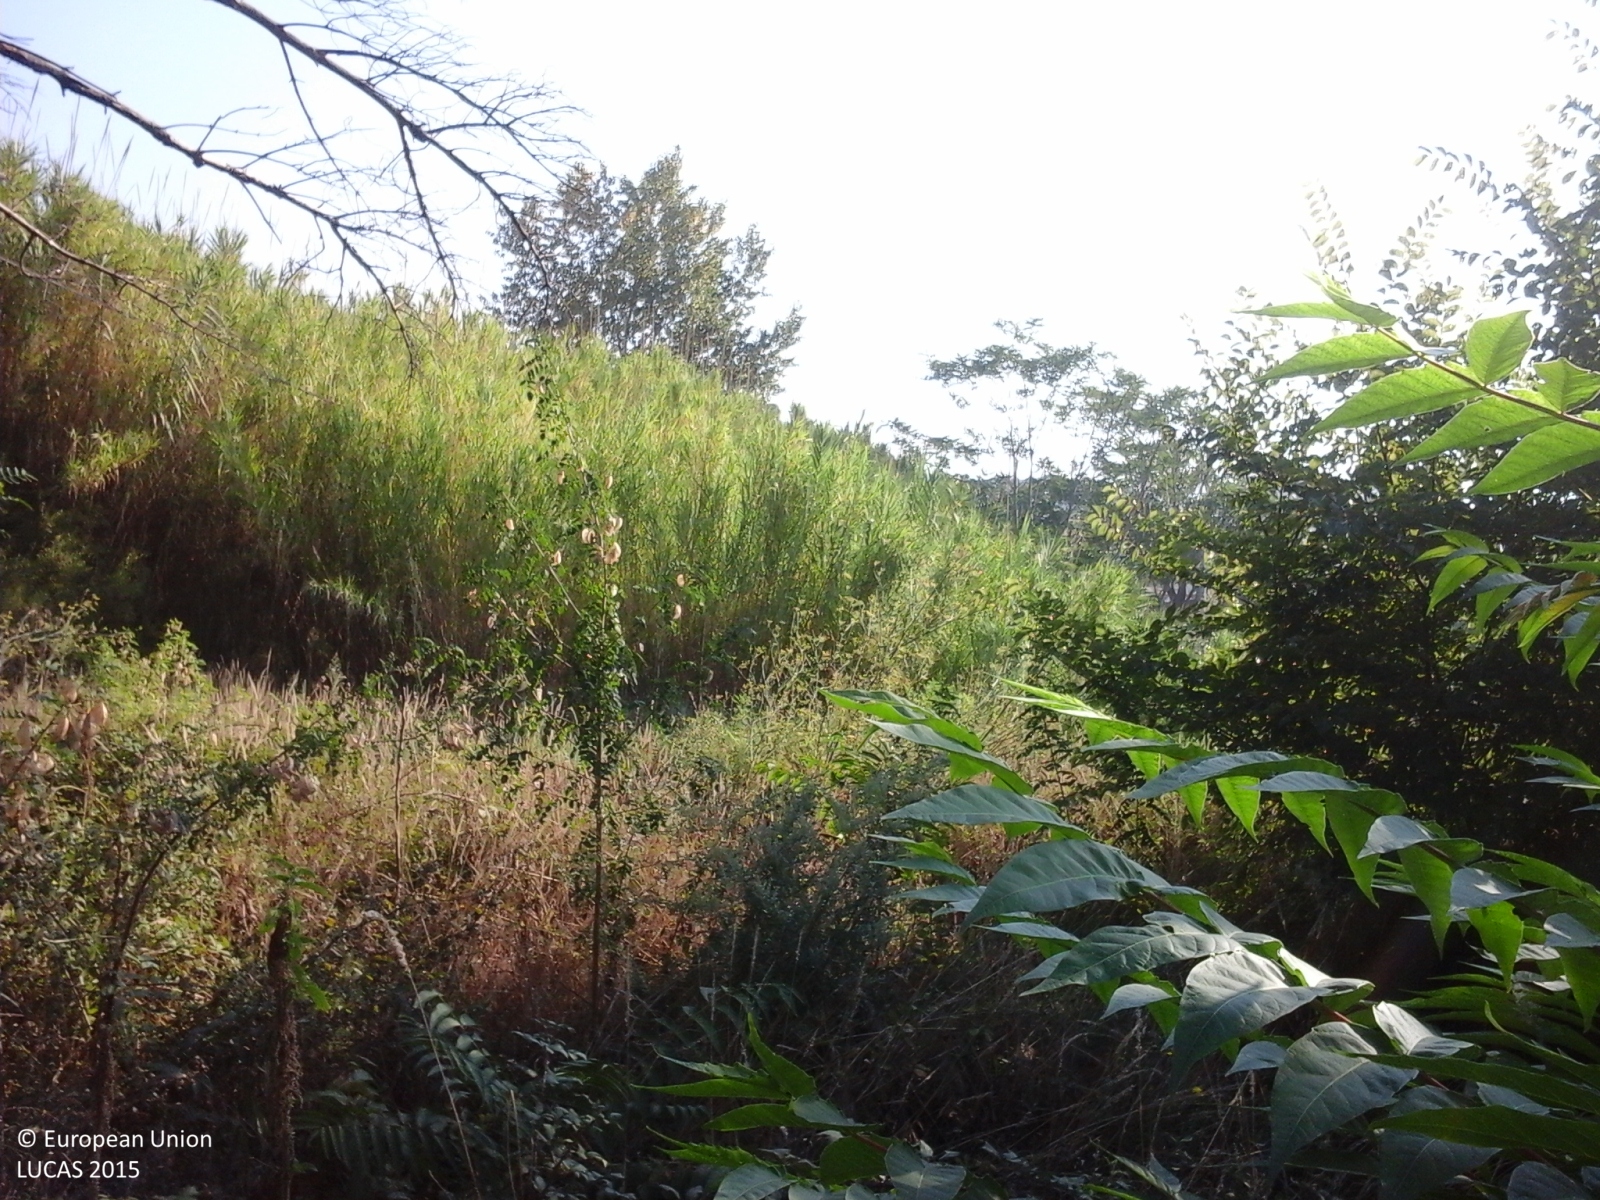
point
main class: Shrubland
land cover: Shrubland with sparse tree cover
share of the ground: > 75 %
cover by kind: shrubs 50 %, herbaceous plants 30 %, broadleaved forest trees 5 %
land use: Semi-natural and natural areas not in use
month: September
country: IT
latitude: 40.7727
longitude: 14.6607
